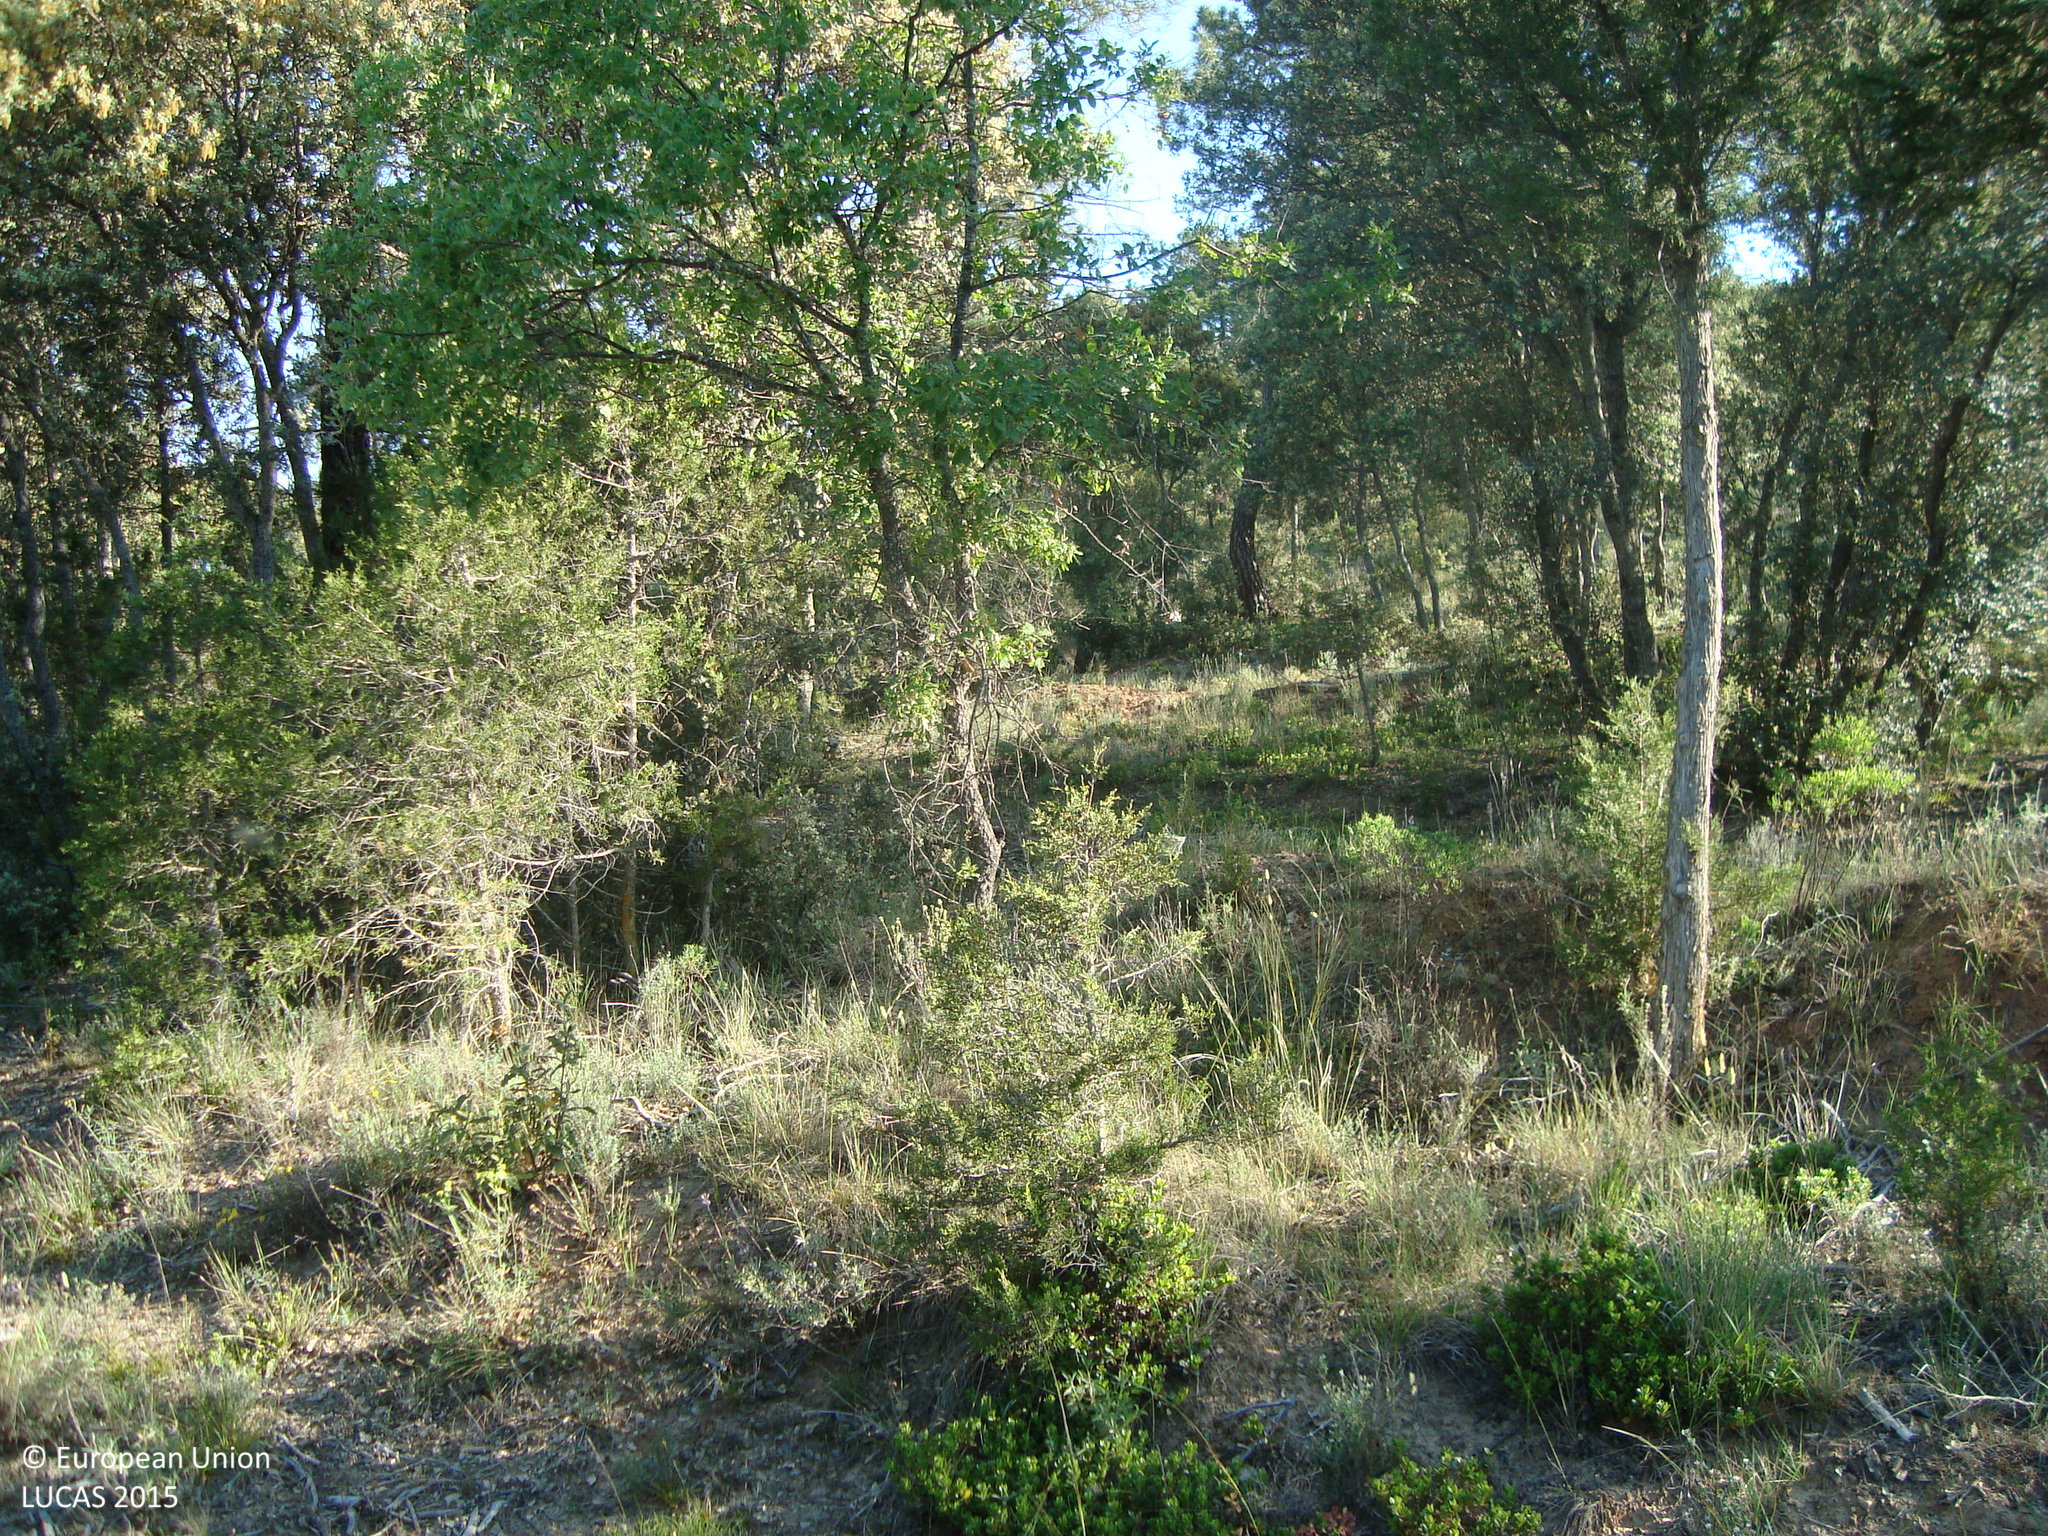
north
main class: Woodland
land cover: Pine dominated mixed woodland
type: coniferous forest of the mediterranean region
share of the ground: 50 - 75 %
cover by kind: broadleaved forest trees 40 %, coniferous forest trees 30 %, shrubs 20 %, herbaceous plants 5 %, unconsolidated bare surface 5 %
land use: Forestry
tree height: > 5 m
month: June
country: ES
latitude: 41.7672
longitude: -3.6095
